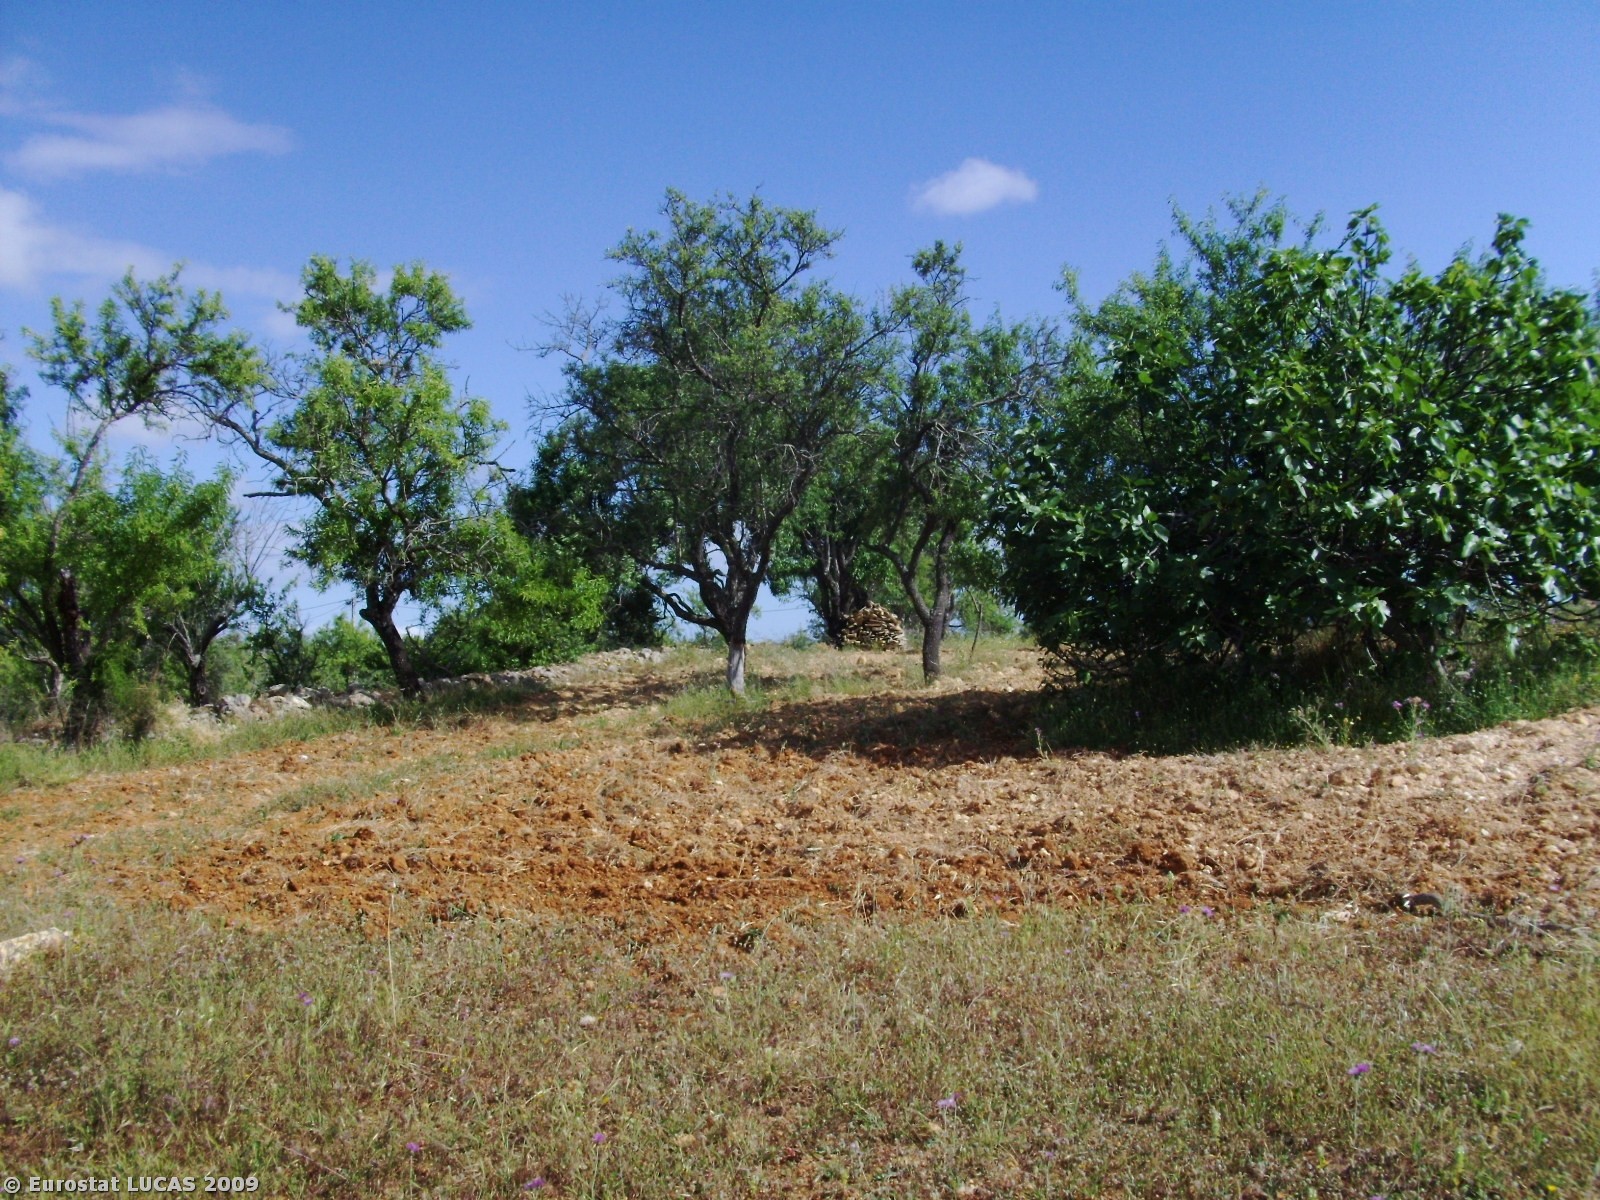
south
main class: Cropland
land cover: Nuts trees
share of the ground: 10 - 25 %
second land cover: Spontaneously vegetated surfaces
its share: 50 - 75 %
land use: Agriculture (excluding fallow land and kitchen gardens)
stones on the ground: 10 - 25 %
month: May
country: PT
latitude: 37.1557
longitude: -8.2258
